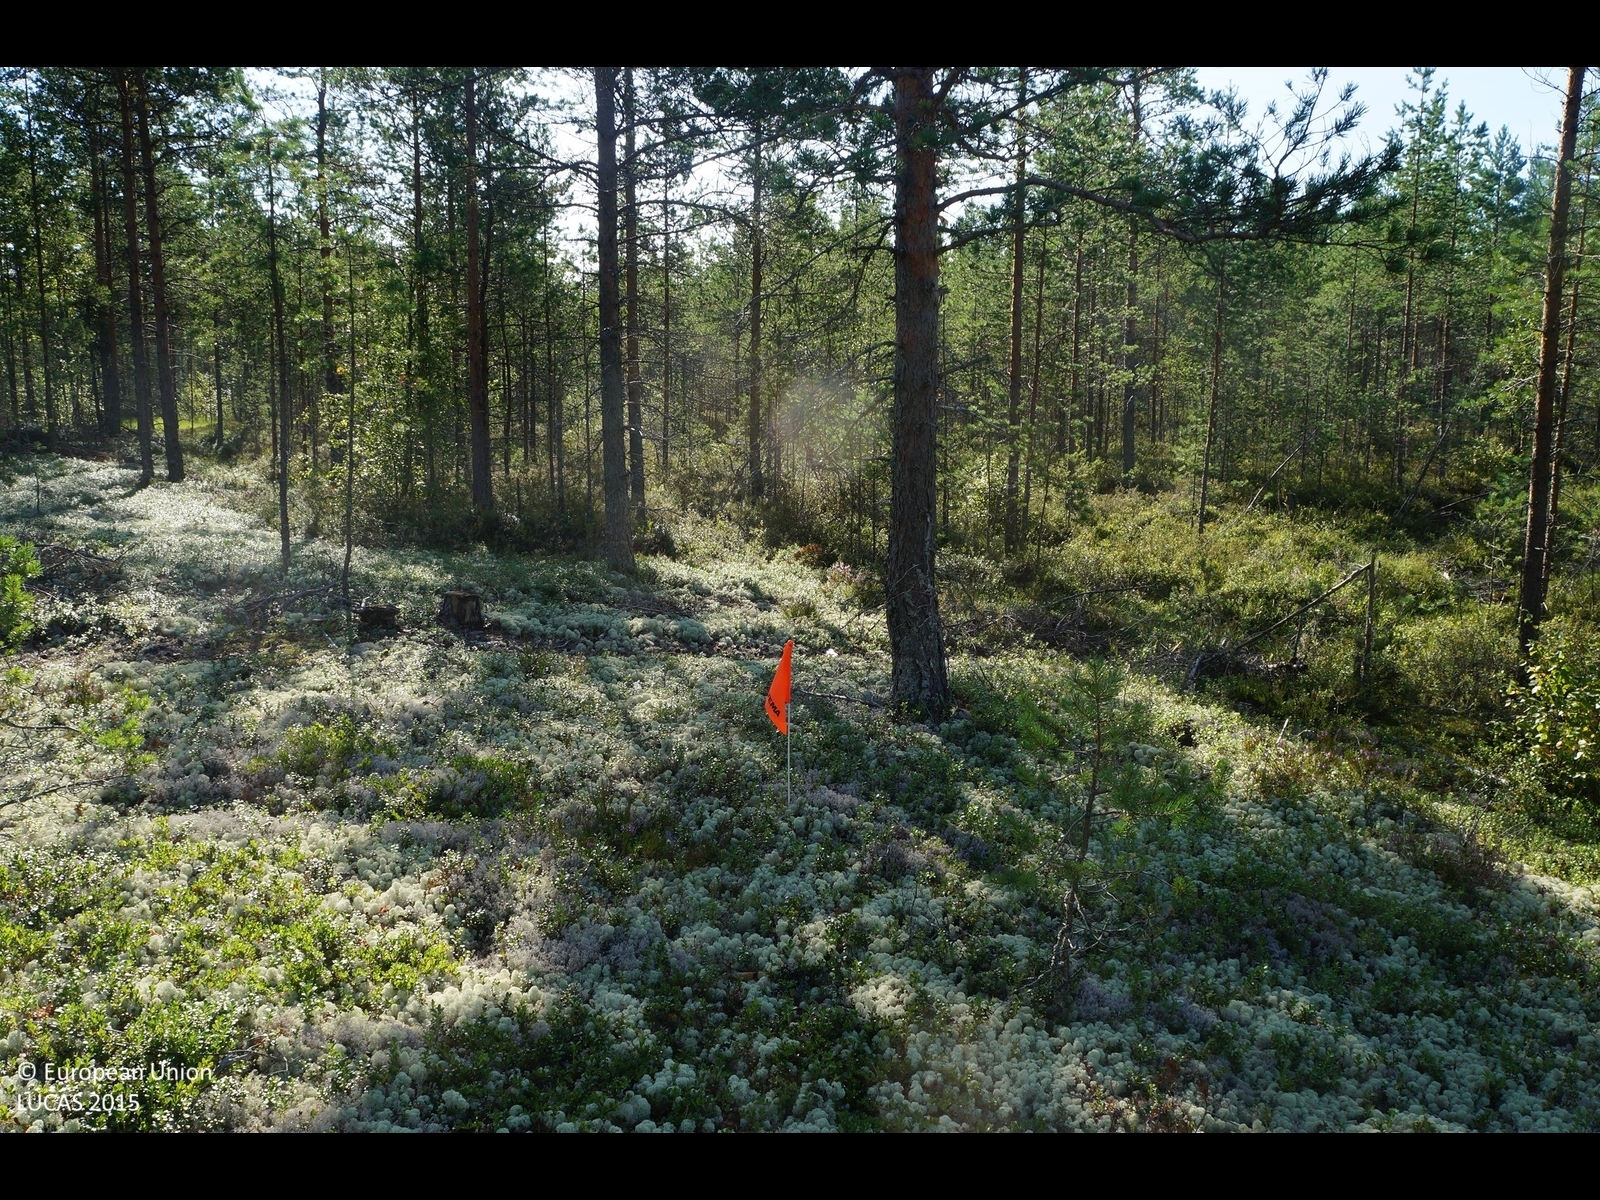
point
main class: Woodland
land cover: Pine dominated coniferous woodland
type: boreal forest
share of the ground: 25 - 50 %
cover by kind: coniferous forest trees 40 %, shrubs 30 %, lichens and mosses 30 %
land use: Forestry
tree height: > 5 m
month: August
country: FI
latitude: 64.8483
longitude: 24.9402
